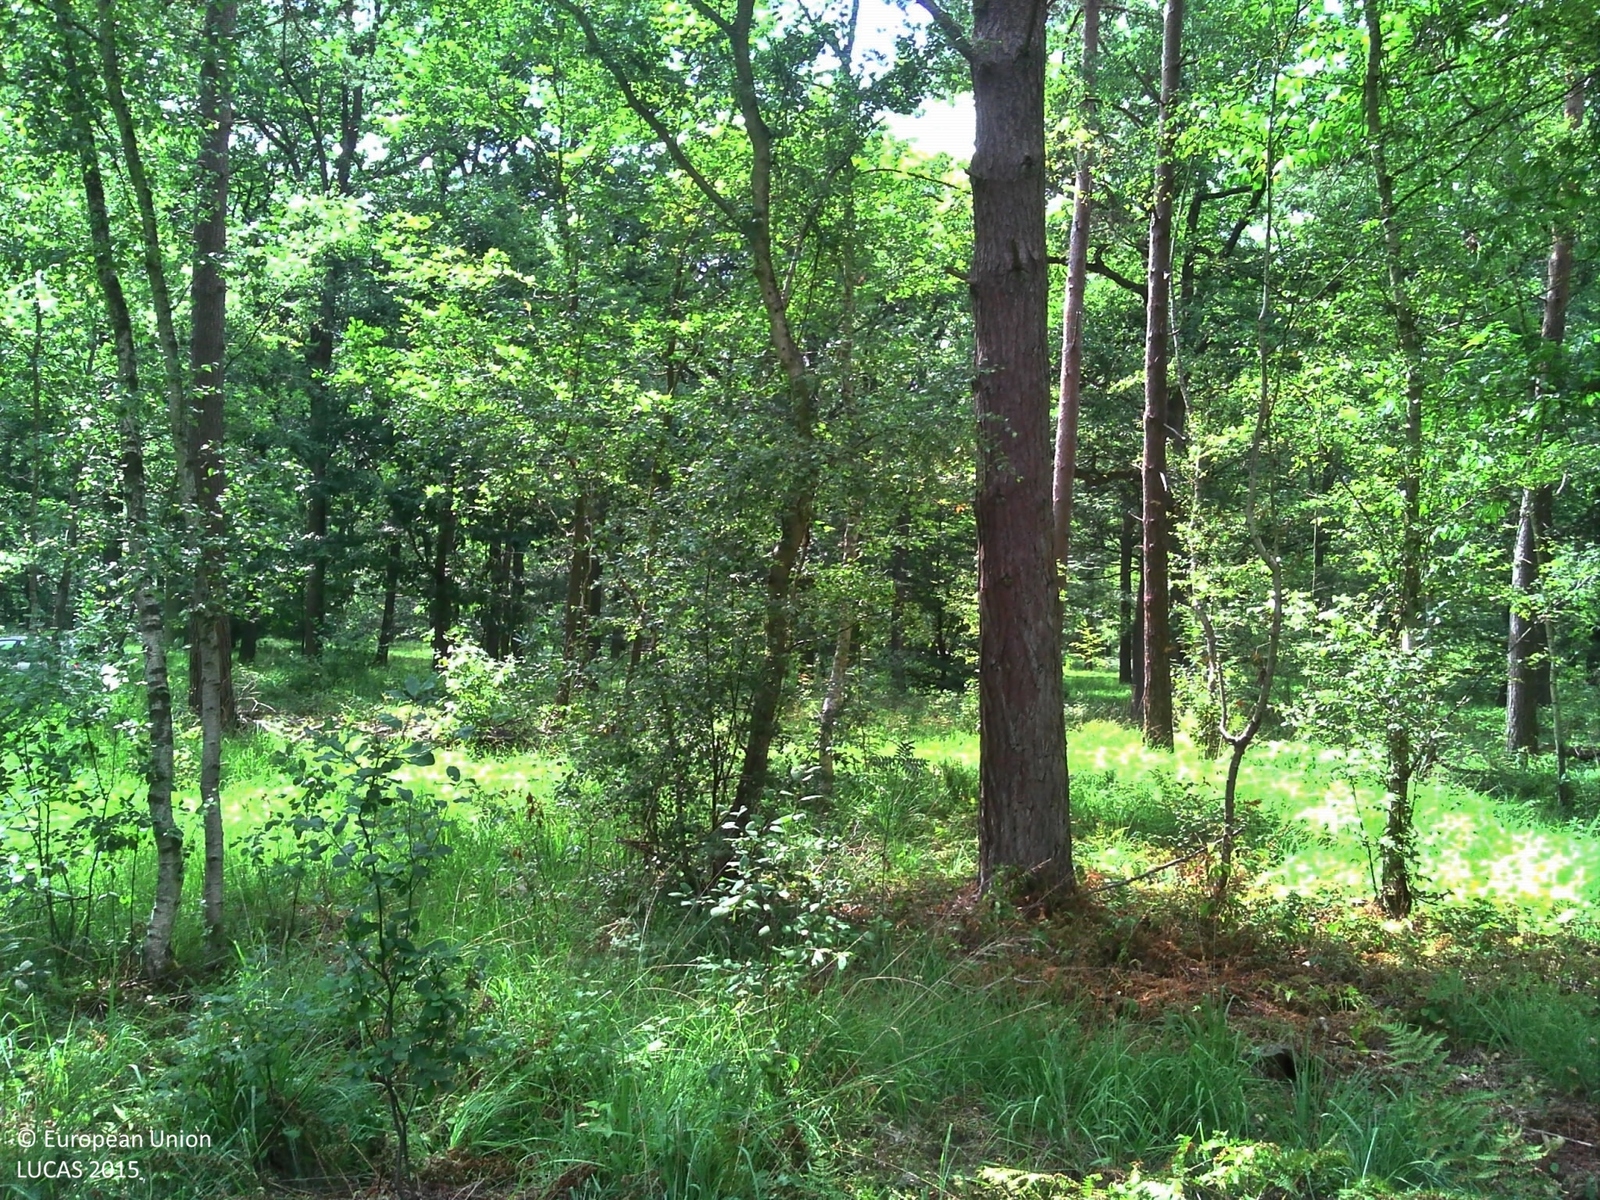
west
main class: Woodland
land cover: Pine dominated mixed woodland
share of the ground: > 75 %
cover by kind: coniferous forest trees 40 %, broadleaved forest trees 30 %, herbaceous plants 20 %, shrubs 10 %
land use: Forestry
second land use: Amenities, museums, leisure
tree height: > 5 m
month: July
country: FR
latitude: 49.1346
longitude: 2.6566
